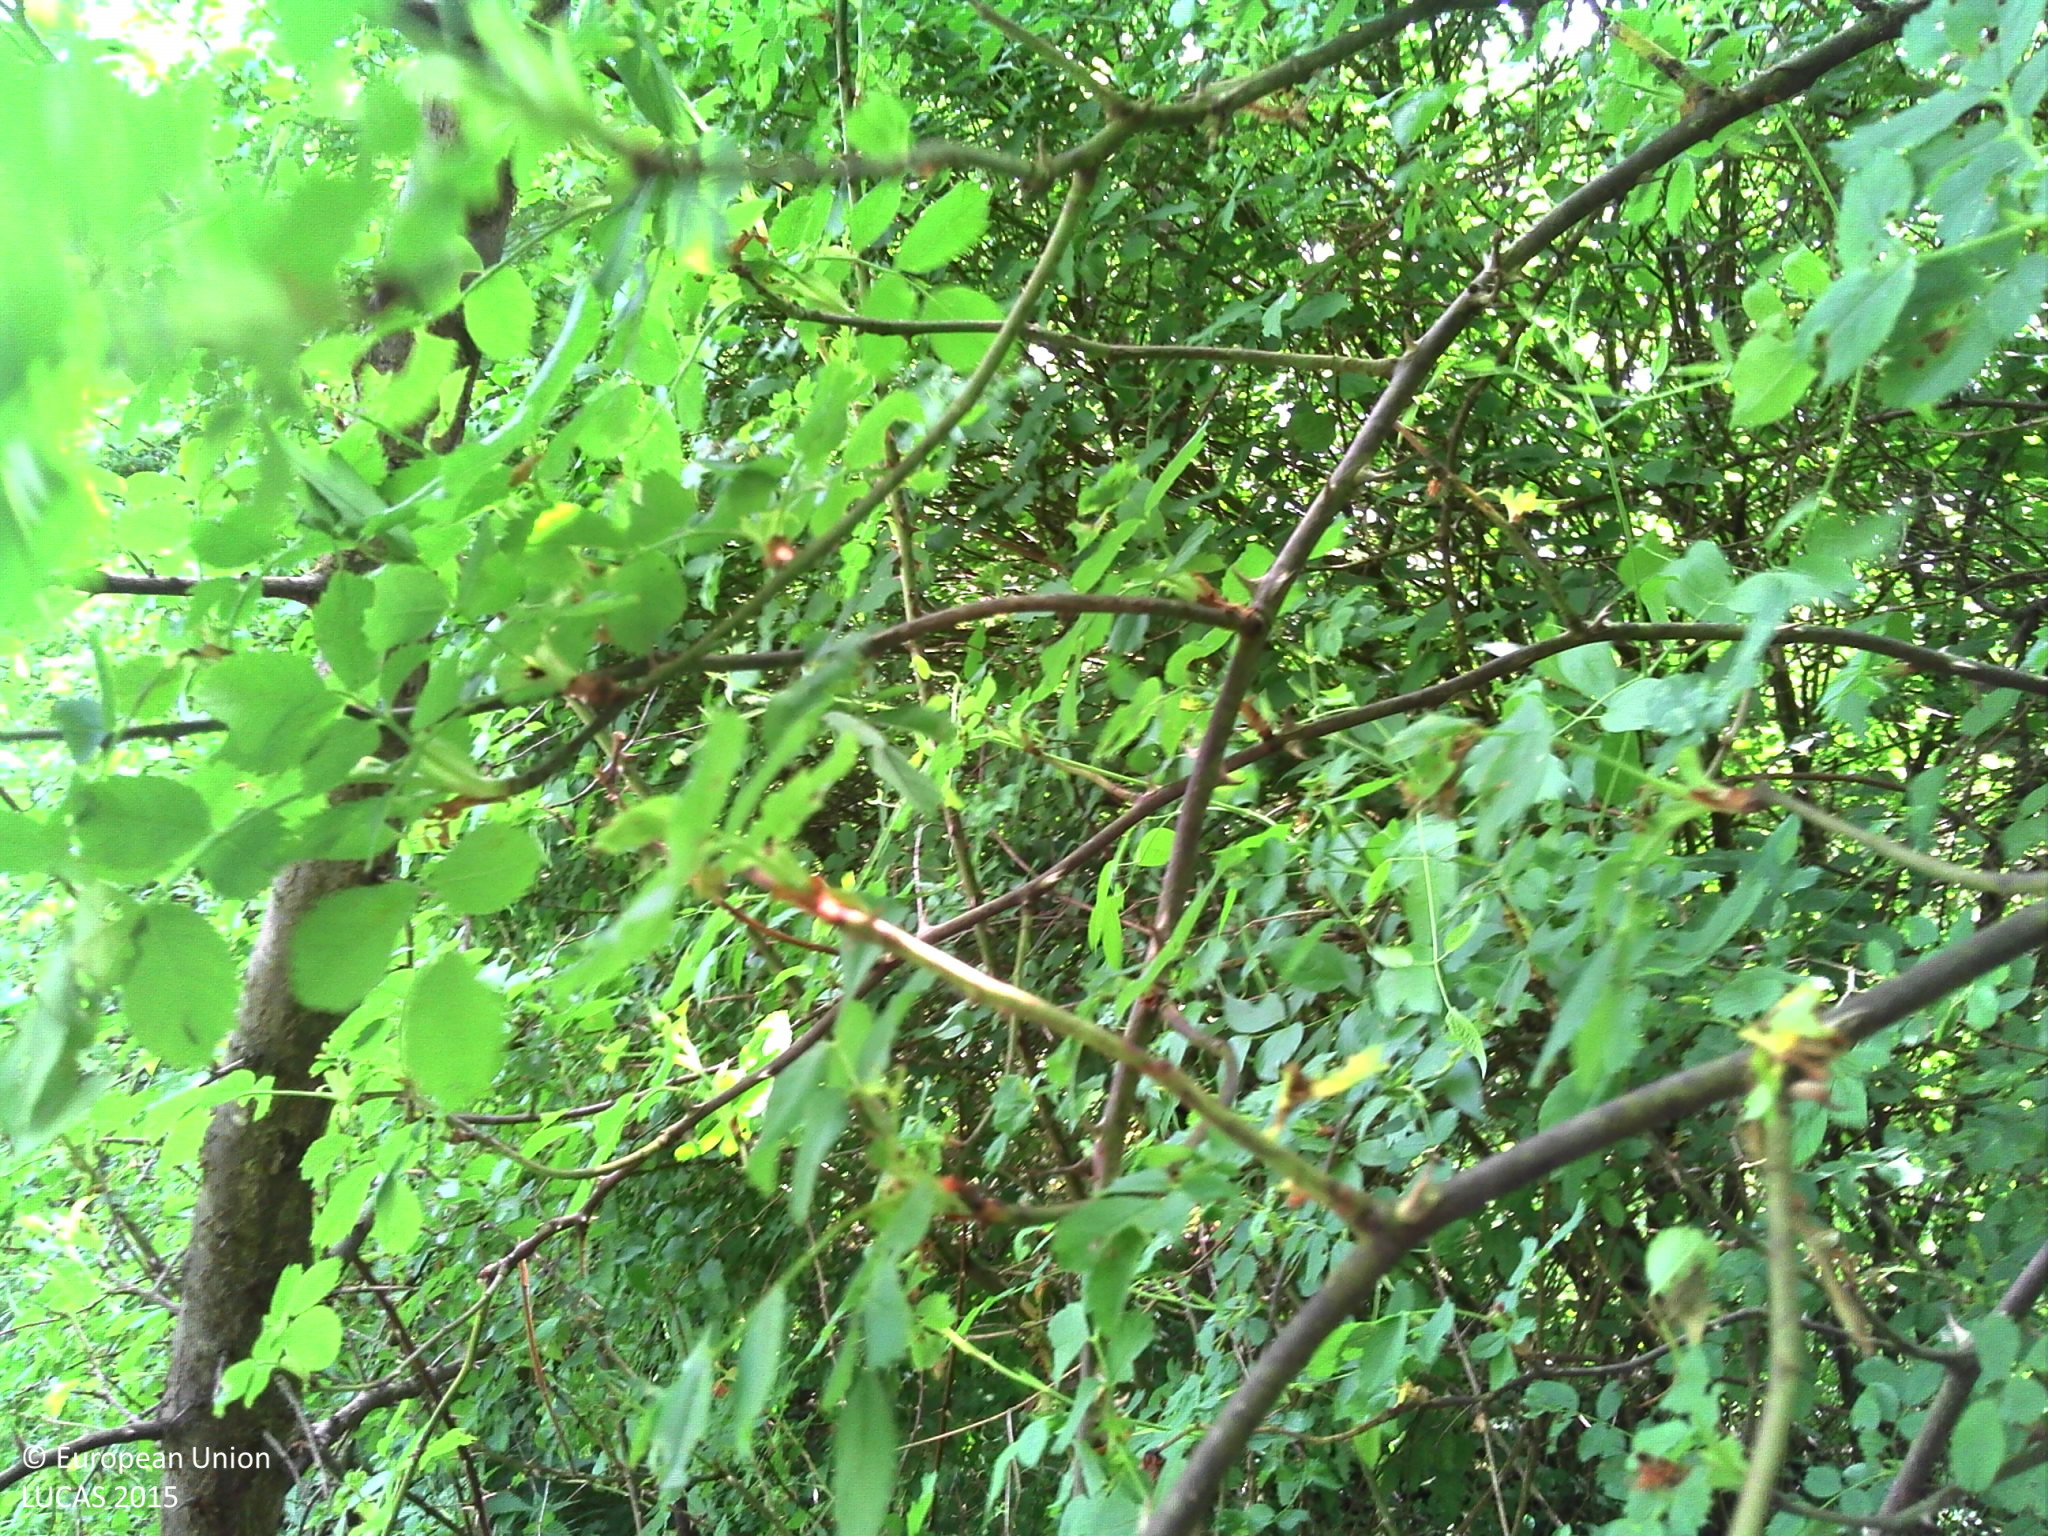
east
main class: Woodland
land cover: Broadleaved woodland
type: mesophytic deciduous forest
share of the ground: > 75 %
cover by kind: broadleaved forest trees 80 %, shrubs 20 %
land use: Semi-natural and natural areas not in use
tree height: > 5 m
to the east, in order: Broadleaved woodland; Grass margins; Broadleaved woodland; Dry stone walls; Paved roads, cycling and walking lanes; Artificial constructions in urban areas; Paved roads, cycling and walking lanes; Broadleaved woodland; Artificial constructions in urban areas; Paved roads, cycling and walking lanes
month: May
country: LU
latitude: 49.7163
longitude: 6.4908
